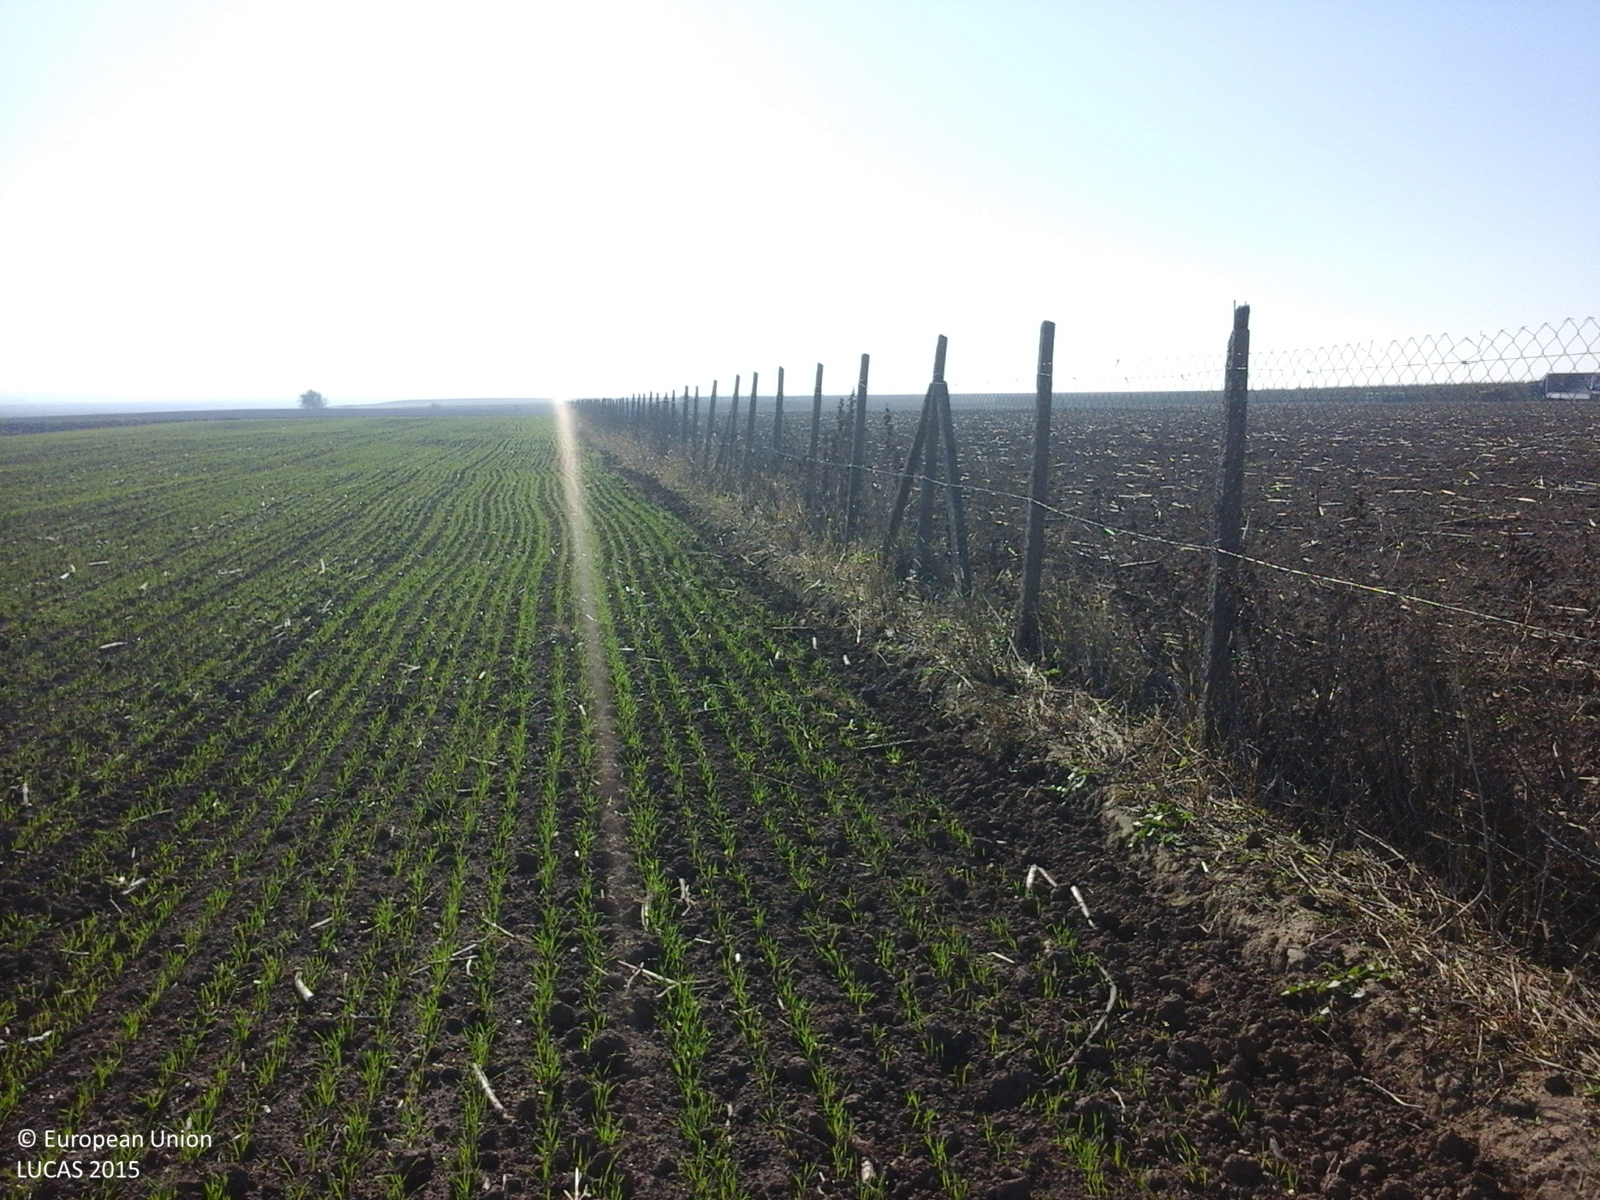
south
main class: Cropland
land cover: Sunflower
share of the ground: 10 - 25 %
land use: Agriculture (excluding fallow land and kitchen gardens)
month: October
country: RO
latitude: 45.9791
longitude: 27.1736
